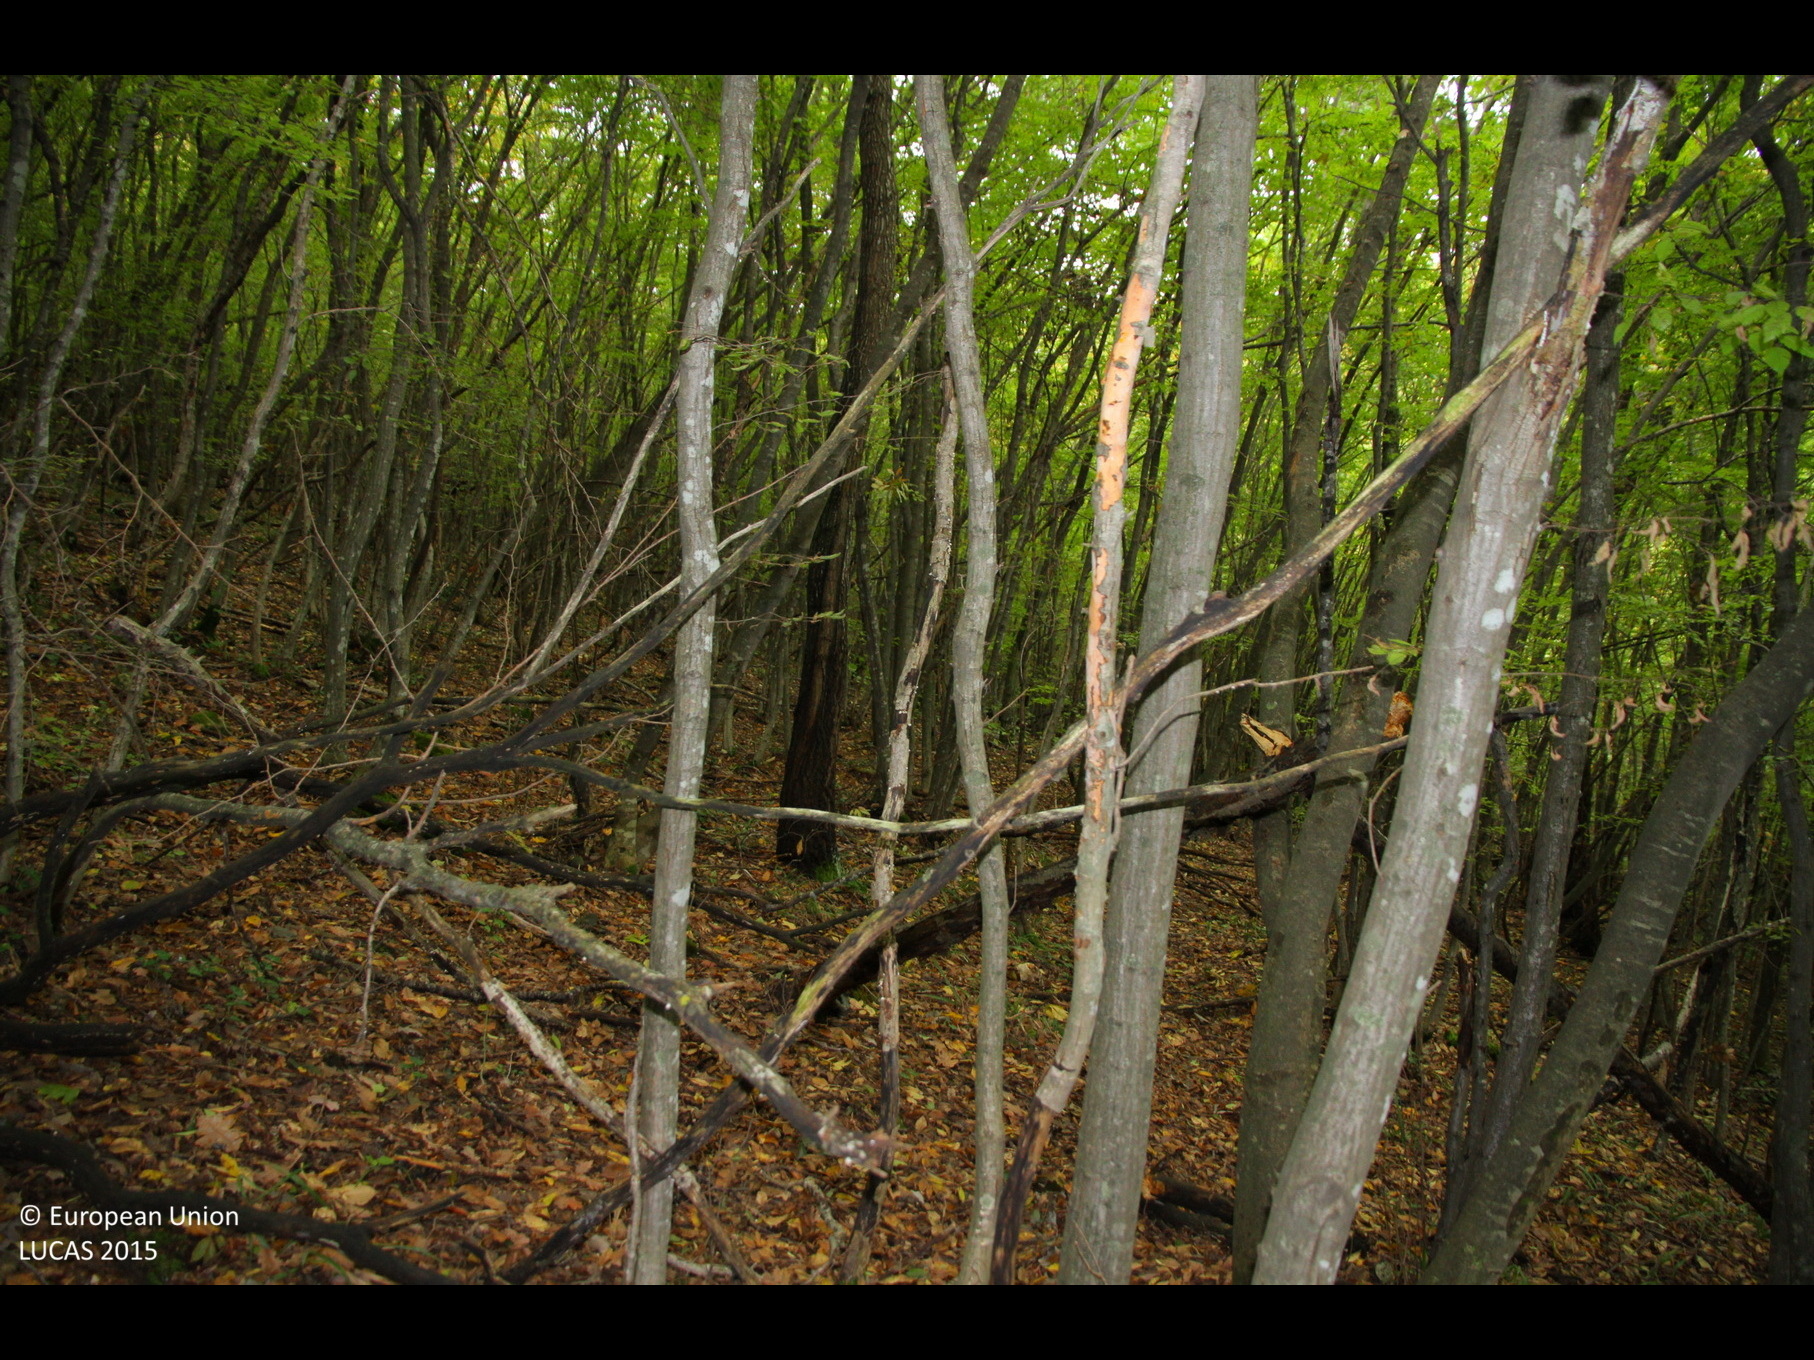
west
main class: Woodland
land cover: Broadleaved woodland
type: beech forest
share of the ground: > 75 %
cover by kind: broadleaved forest trees 100 %
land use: Forestry
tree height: > 5 m
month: October
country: BG
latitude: 43.4718
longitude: 27.0922
